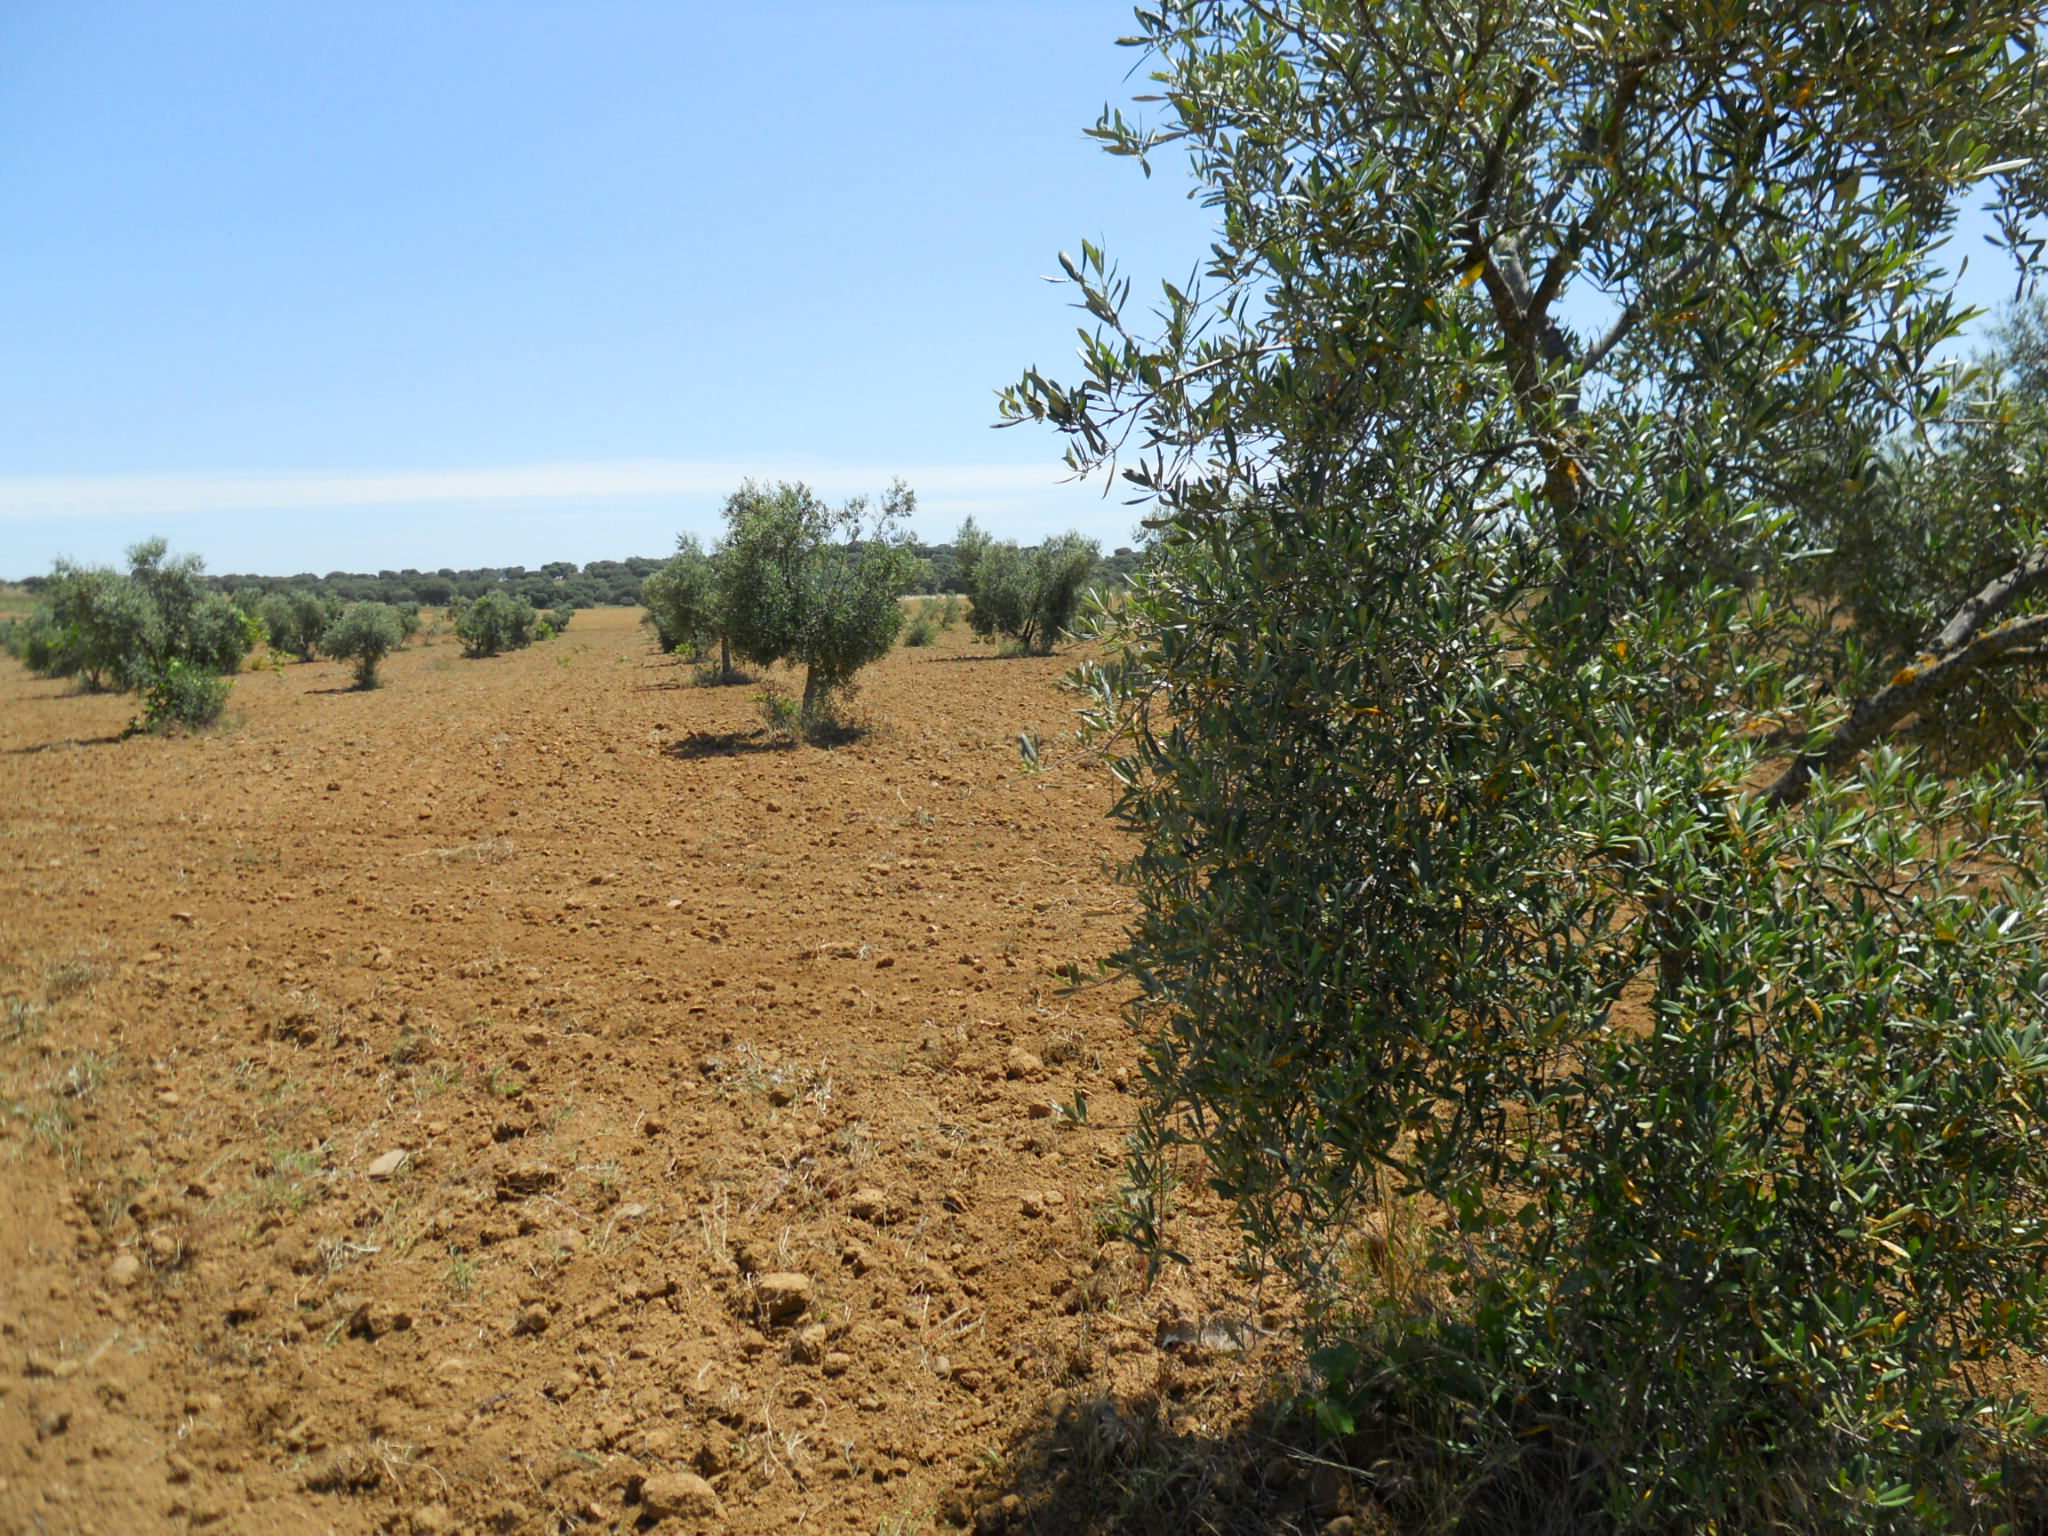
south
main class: Cropland
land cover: Olive groves
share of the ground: 10 - 25 %
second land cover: Other bare soil
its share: > 75 %
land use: Agriculture (excluding fallow land and kitchen gardens)
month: May
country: ES
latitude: 39.0312
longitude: -6.5717
